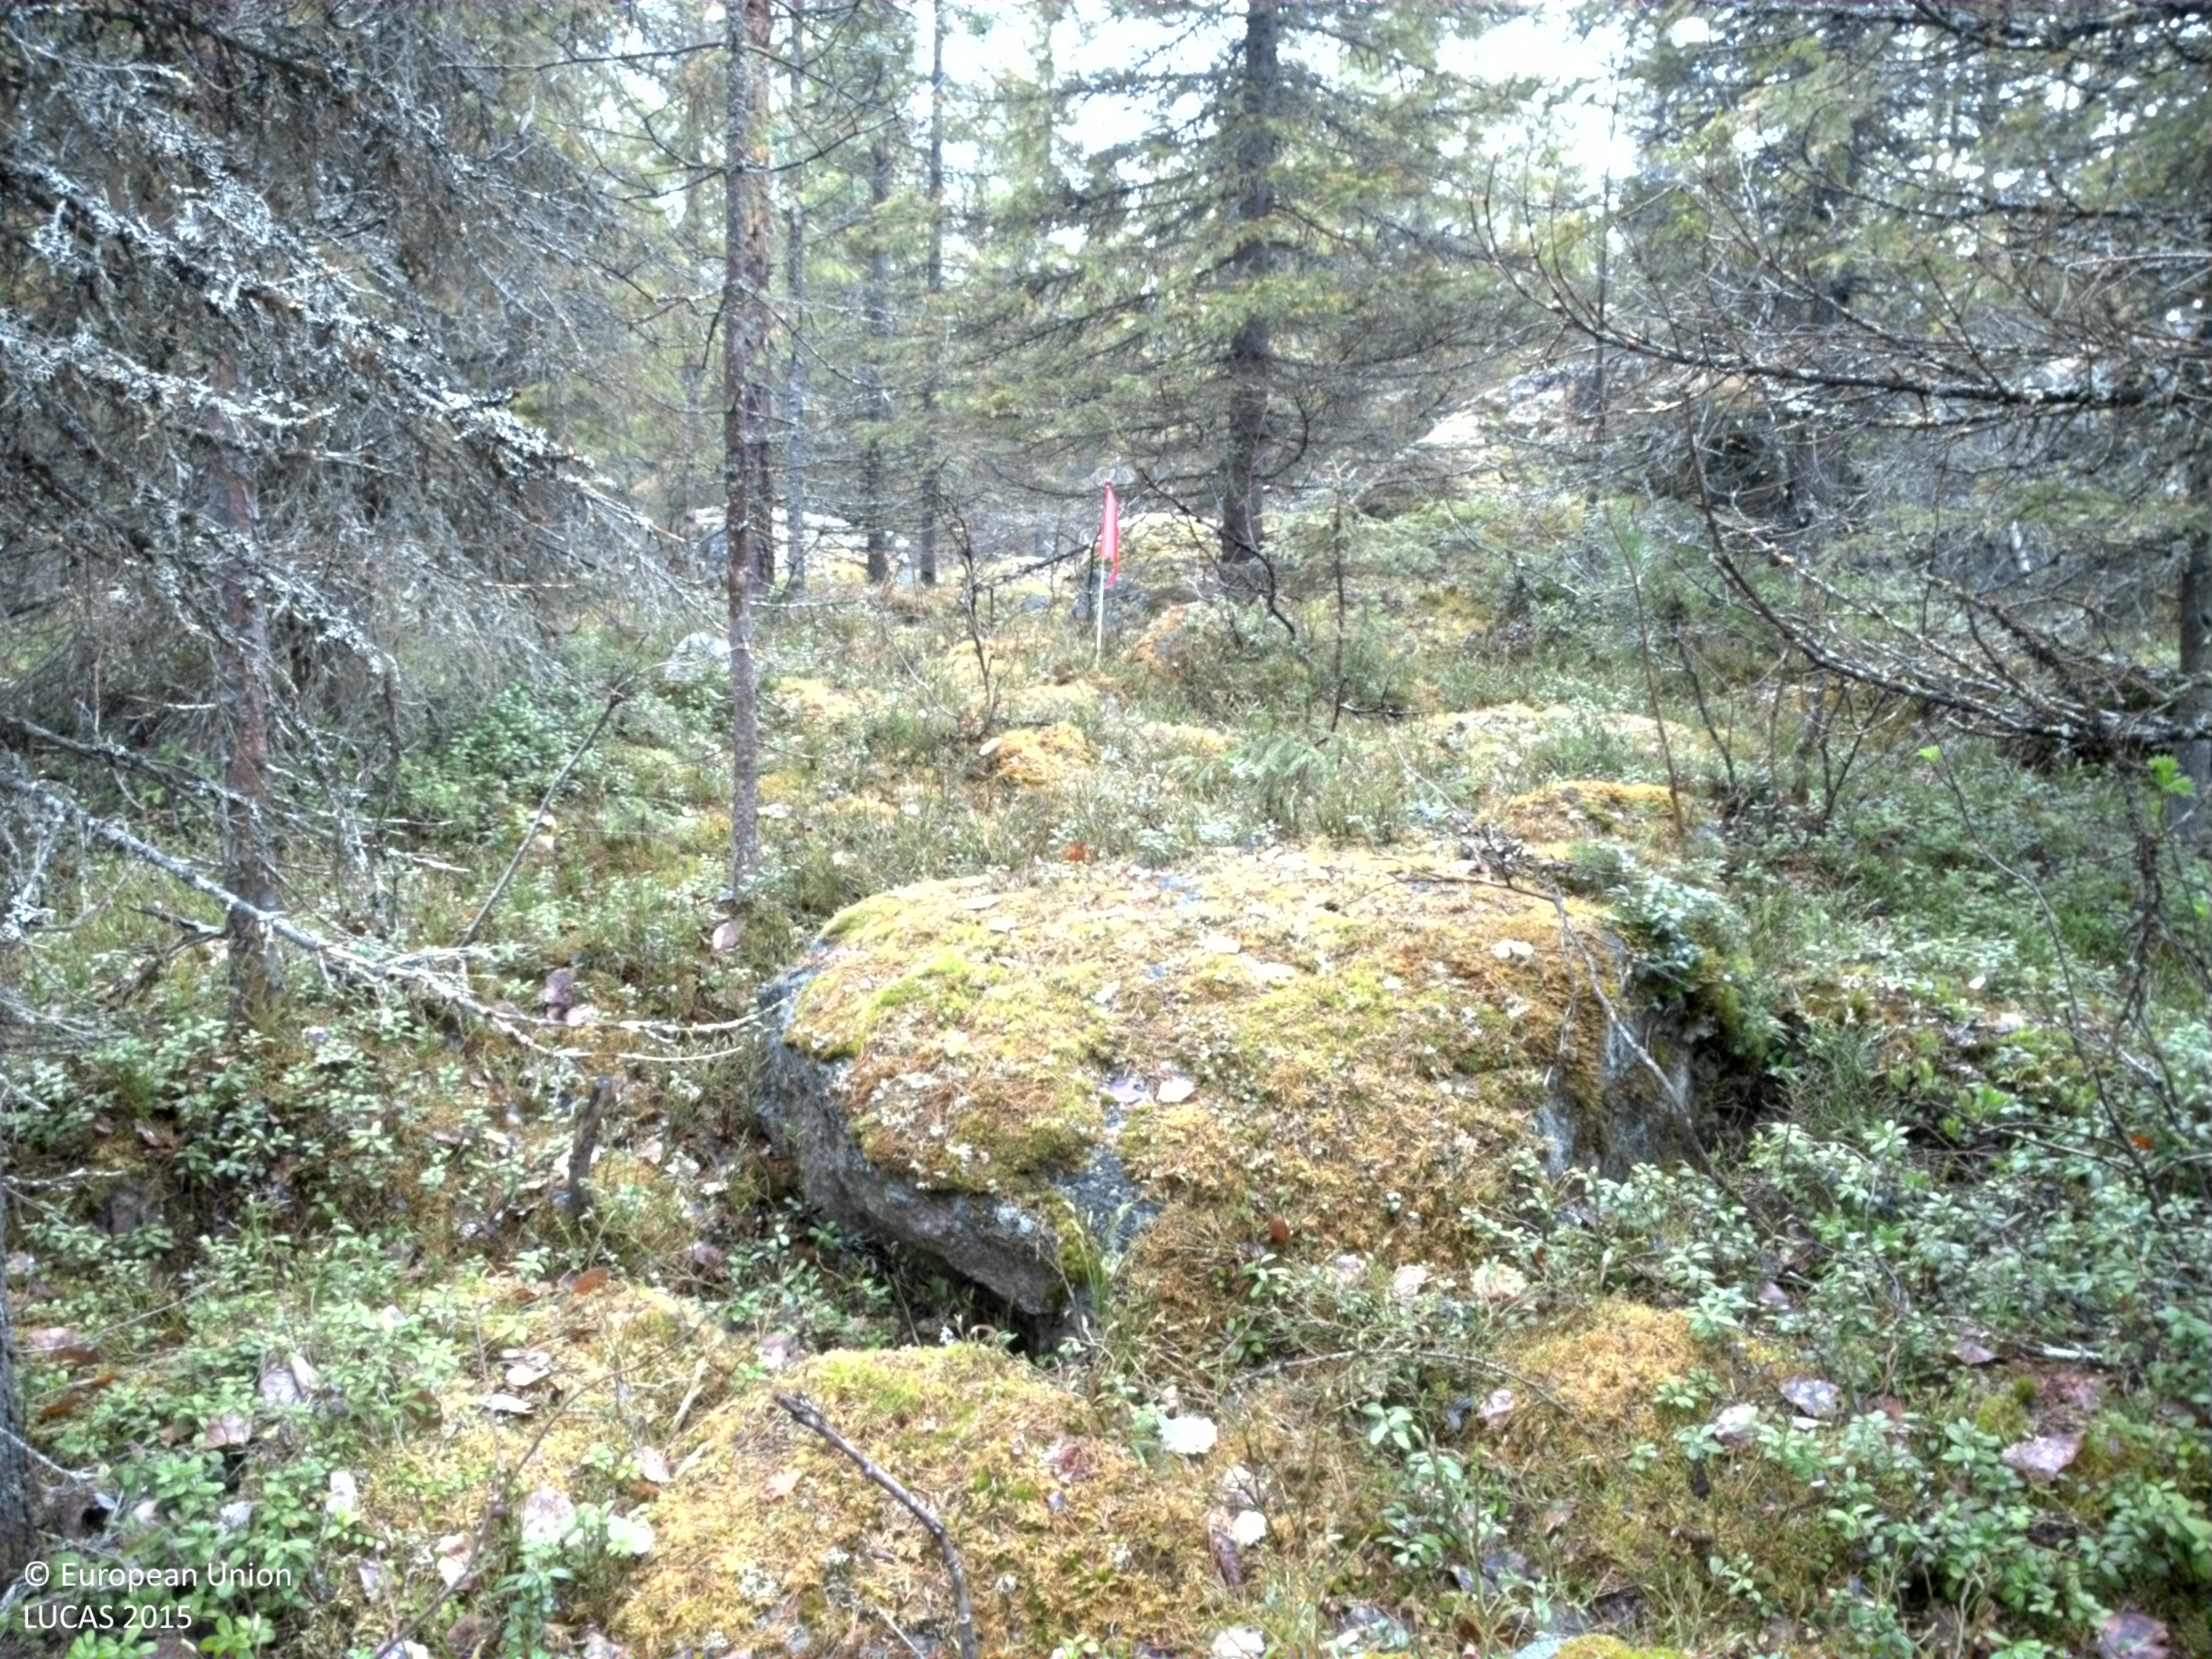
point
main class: Woodland
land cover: Spruce dominated coniferous woodland
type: boreal forest
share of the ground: > 75 %
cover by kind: coniferous forest trees 85 %, shrubs 10 %, lichens and mosses 5 %
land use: Forestry
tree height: > 5 m
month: May
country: SE
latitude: 66.0913
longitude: 23.1416
